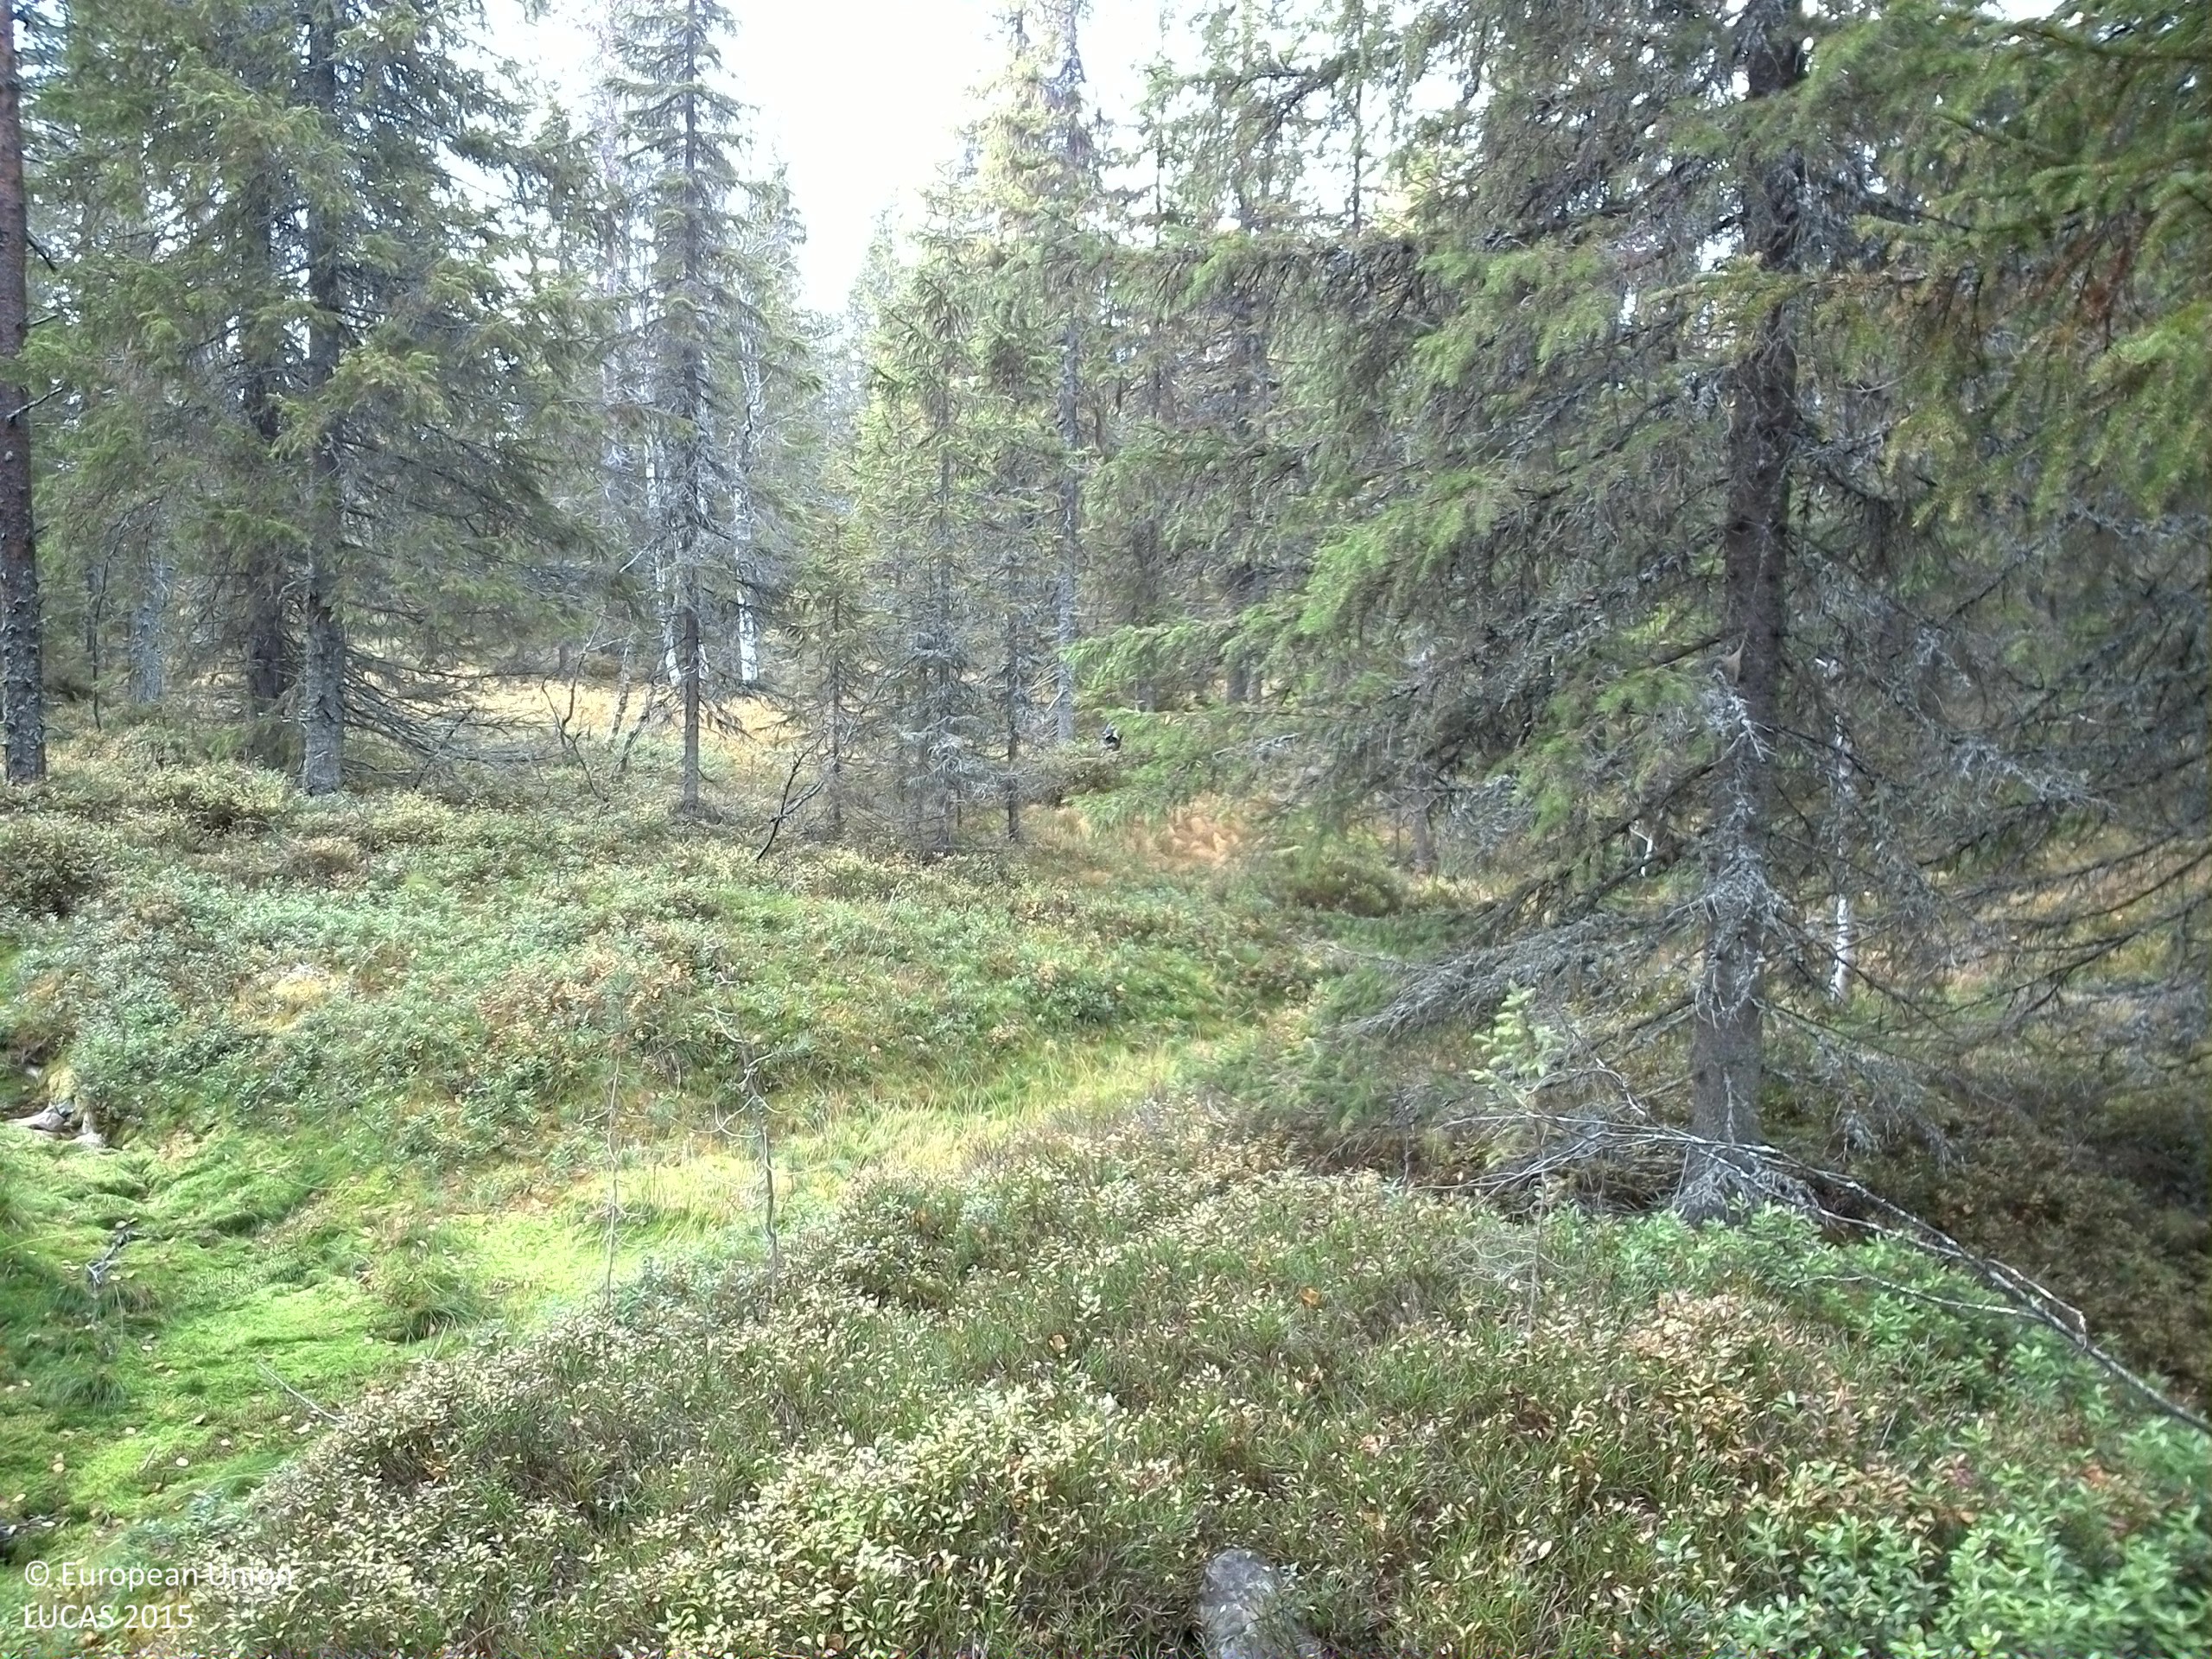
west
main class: Woodland
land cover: Spruce dominated mixed woodland
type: boreal forest
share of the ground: 50 - 75 %
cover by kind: coniferous forest trees 40 %, shrubs 30 %, broadleaved forest trees 20 %, lichens and mosses 10 %
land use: Forestry
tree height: > 5 m
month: October
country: SE
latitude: 61.4211
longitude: 14.6512
